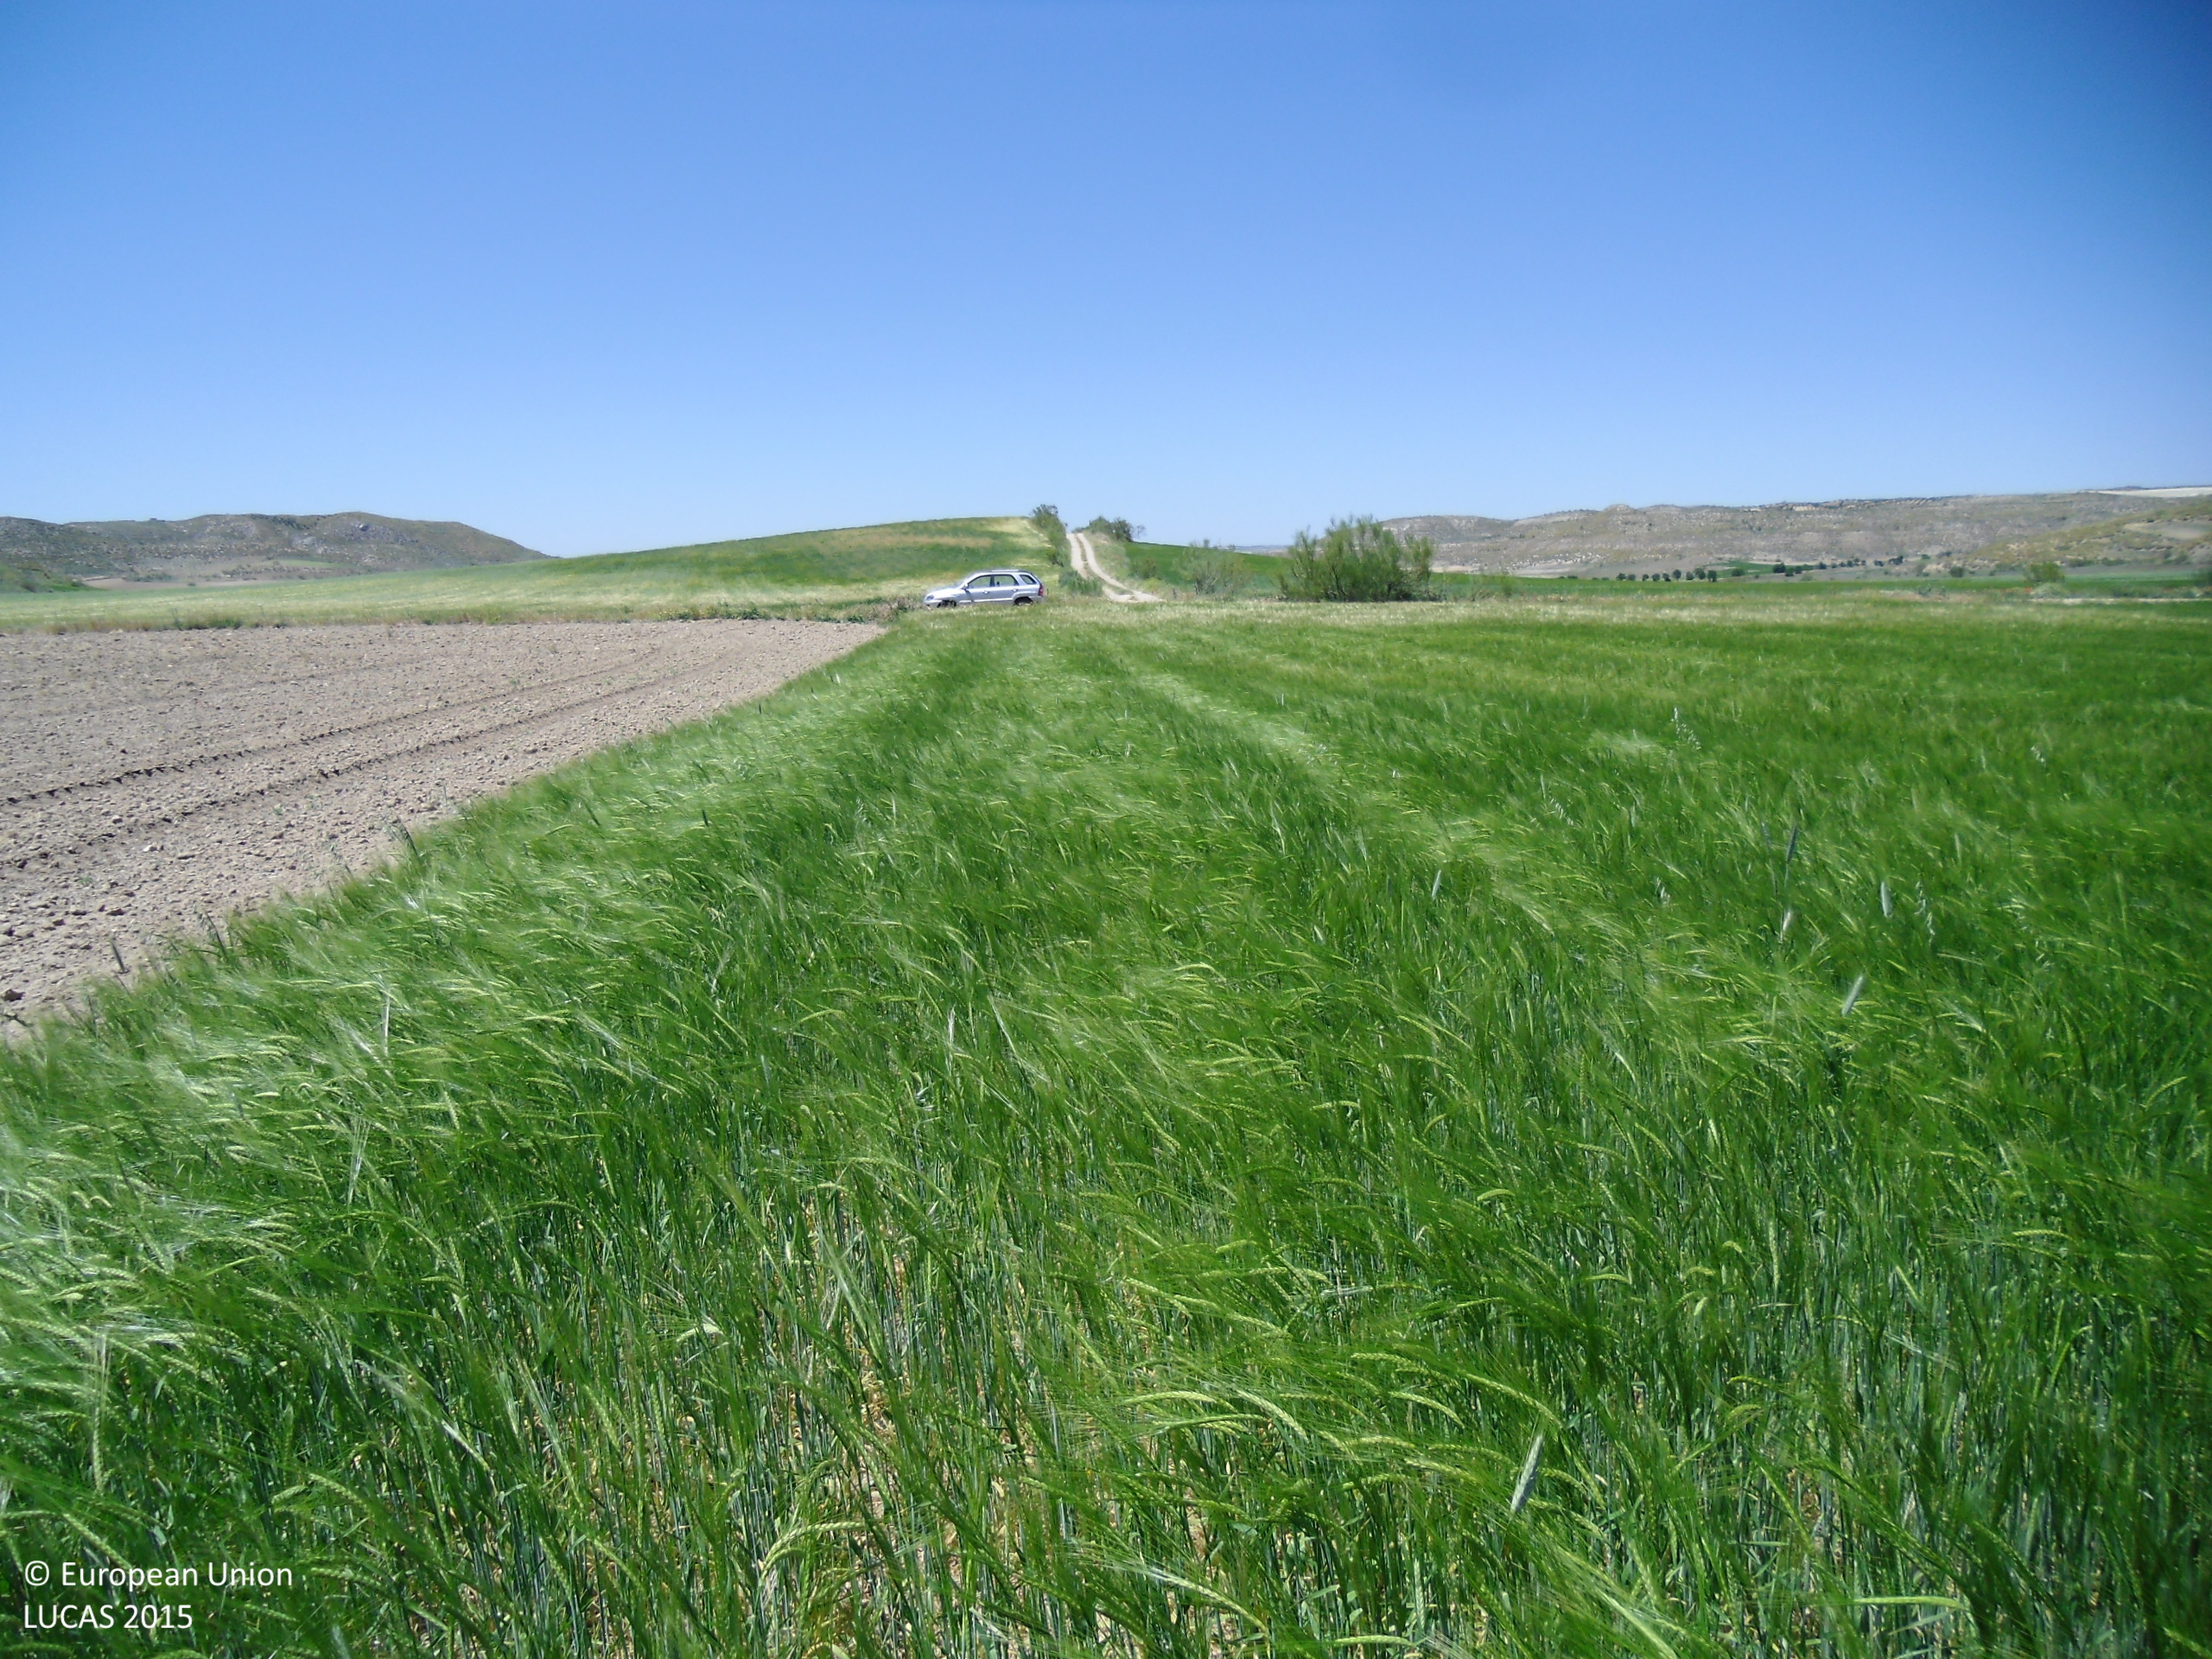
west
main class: Cropland
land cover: Barley
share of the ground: > 75 %
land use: Agriculture (excluding fallow land and kitchen gardens)
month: May
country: ES
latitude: 40.1761
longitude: -2.9311
